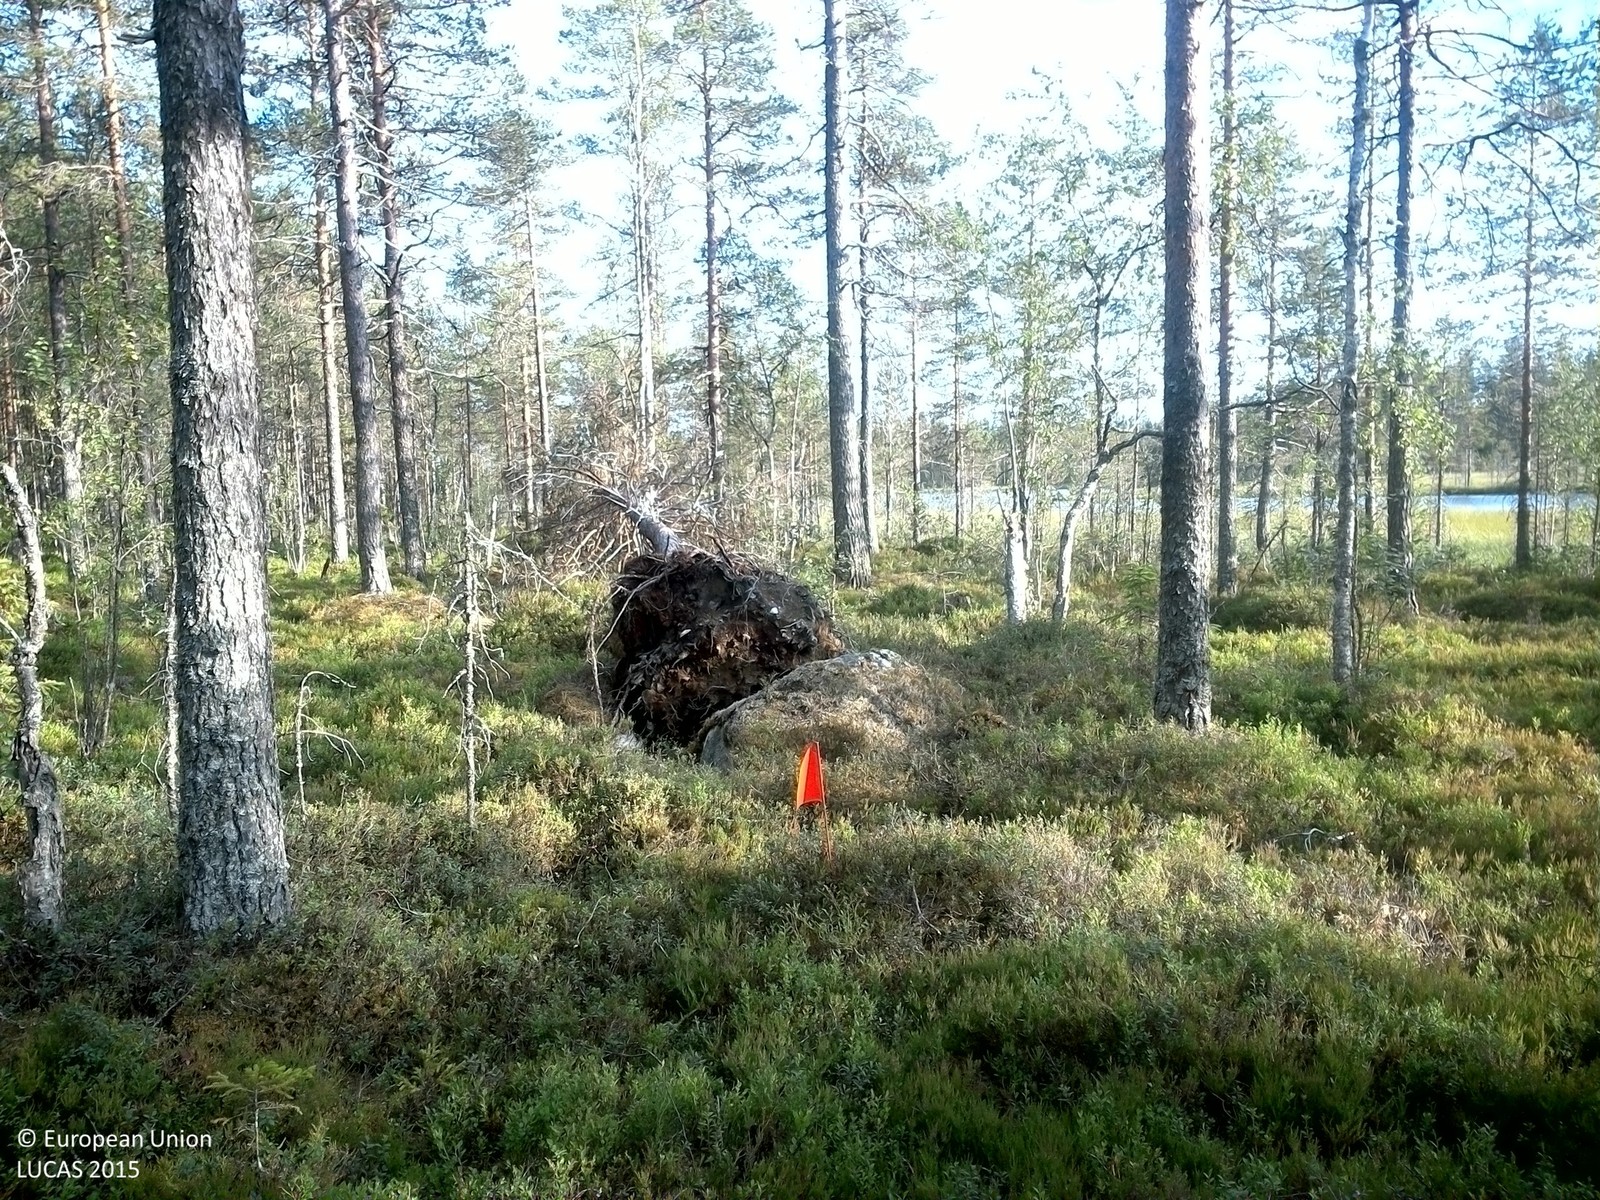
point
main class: Woodland
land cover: Pine dominated mixed woodland
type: boreal forest
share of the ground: 25 - 50 %
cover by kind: shrubs 40 %, coniferous forest trees 35 %, broadleaved forest trees 15 %, herbaceous plants 5 %, lichens and mosses 5 %
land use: Forestry
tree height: > 5 m
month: August
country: SE
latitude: 62.8503
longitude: 16.9508
